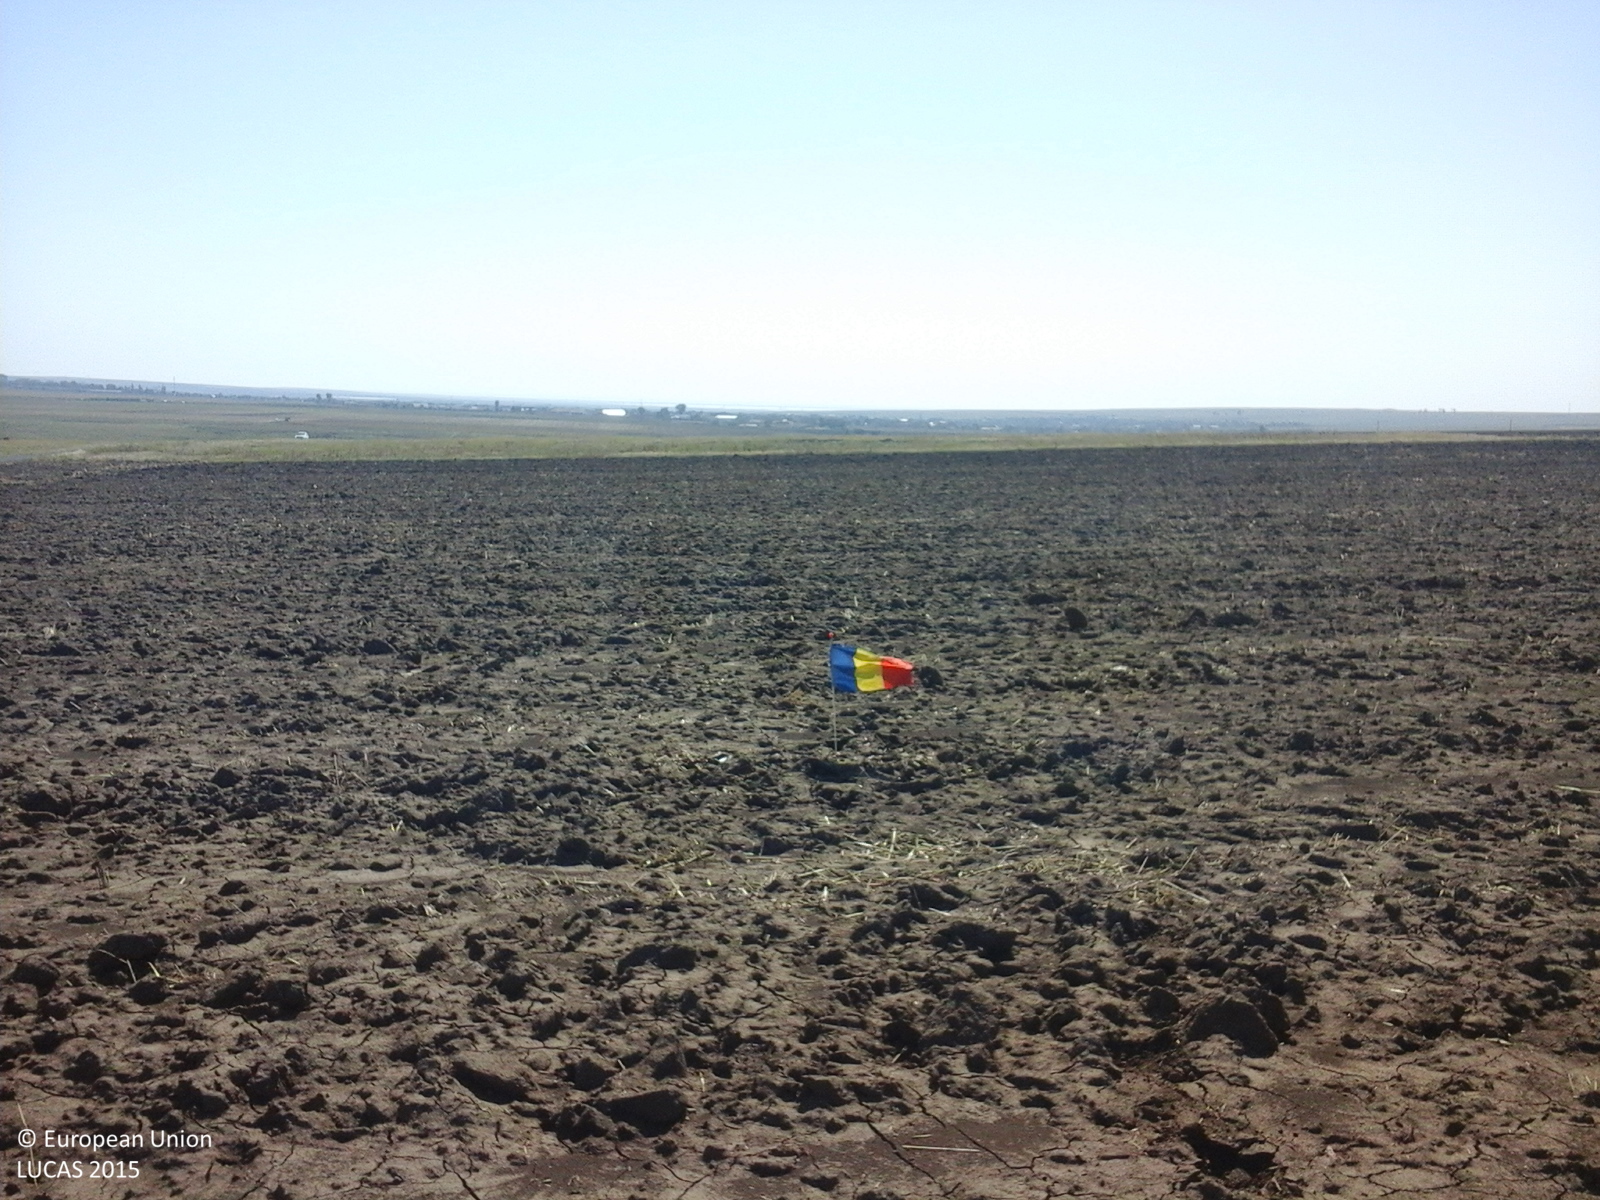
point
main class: Cropland
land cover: Common wheat
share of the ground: < 10 %
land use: Agriculture (excluding fallow land and kitchen gardens)
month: August
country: RO
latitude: 44.5674
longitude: 28.5211
